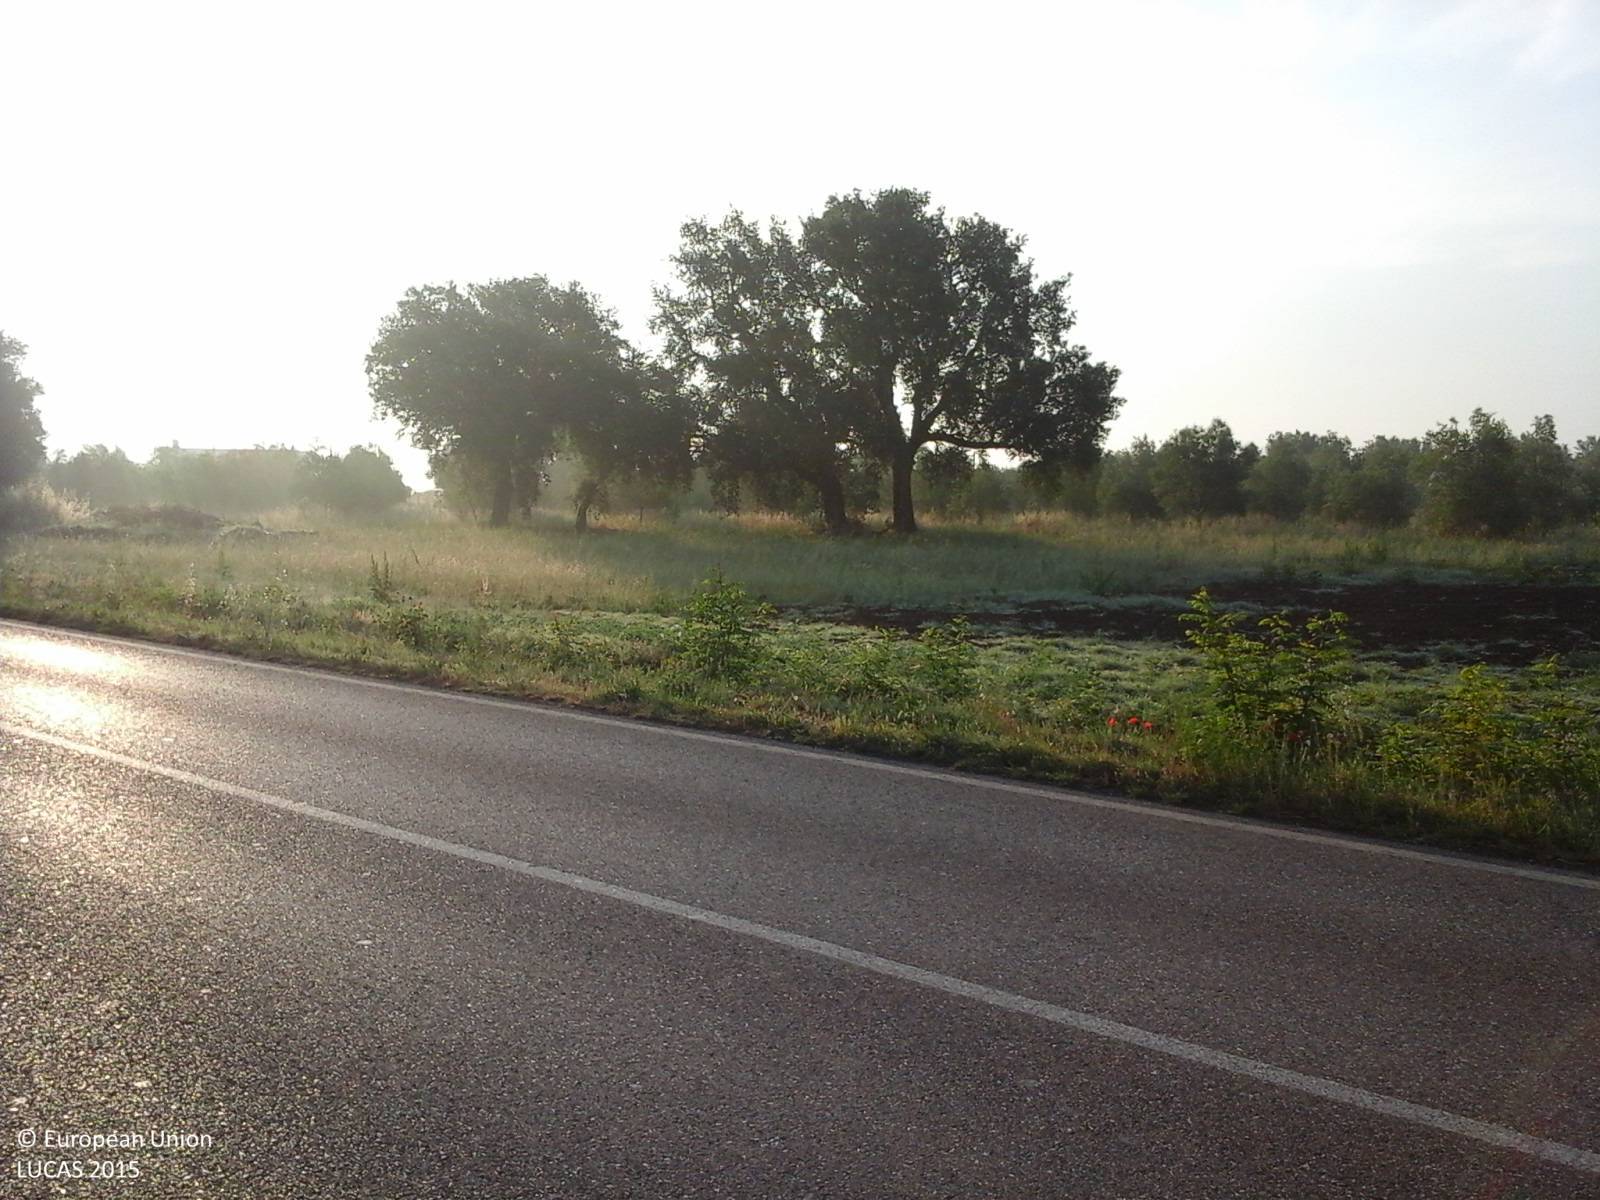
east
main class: Grassland
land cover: Grassland without tree/shrub cover
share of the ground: > 75 %
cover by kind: herbaceous plants 100 %
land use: Logistics and storage
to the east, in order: Grassland without tree/shrub cover; Abandoned hedges; Artificial constructions in urban areas; Grass margins; Paved roads, cycling and walking lanes; Grass margins; Ditches and canals; Spontaneously vegetated surfaces; Olive groves; Artificial constructions in urban areas
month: June
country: IT
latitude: 42.4194
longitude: 11.9015
